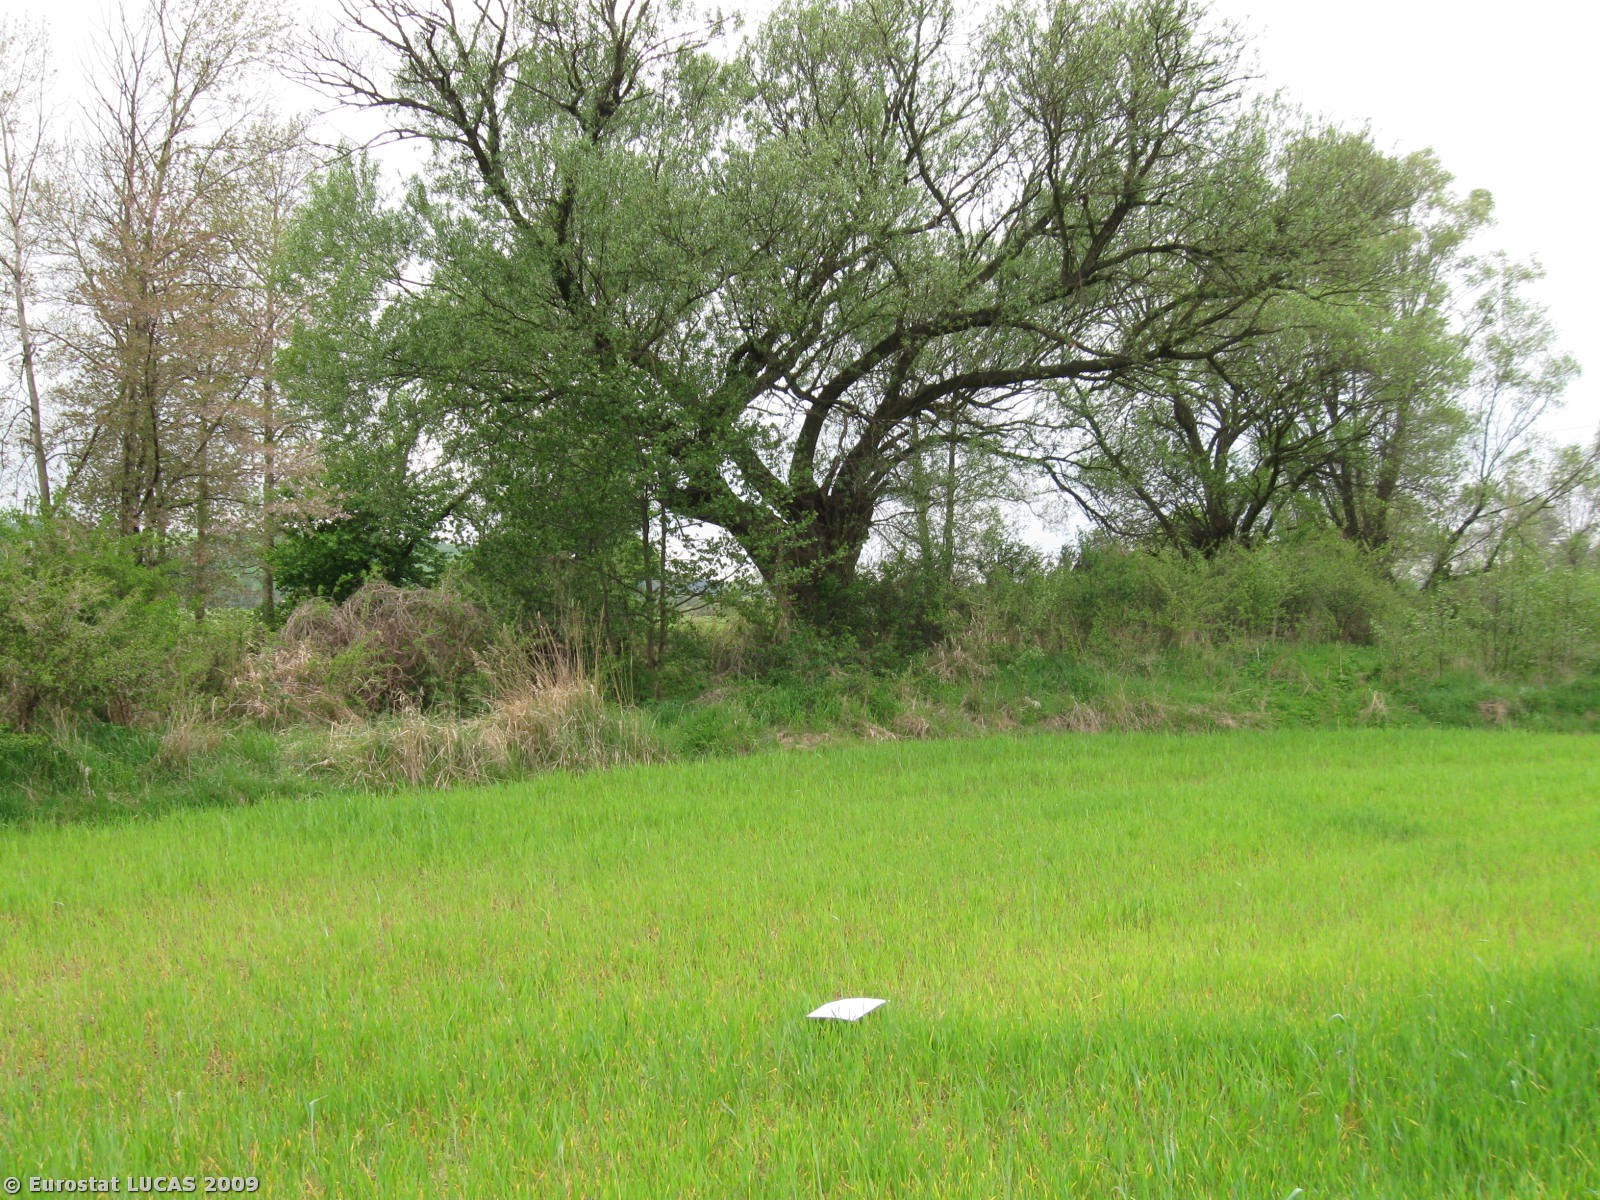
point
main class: Cropland
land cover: Rye
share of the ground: > 75 %
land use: Agriculture (excluding fallow land and kitchen gardens)
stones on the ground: < 10 %
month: May
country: PL
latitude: 50.9455
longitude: 21.3067
